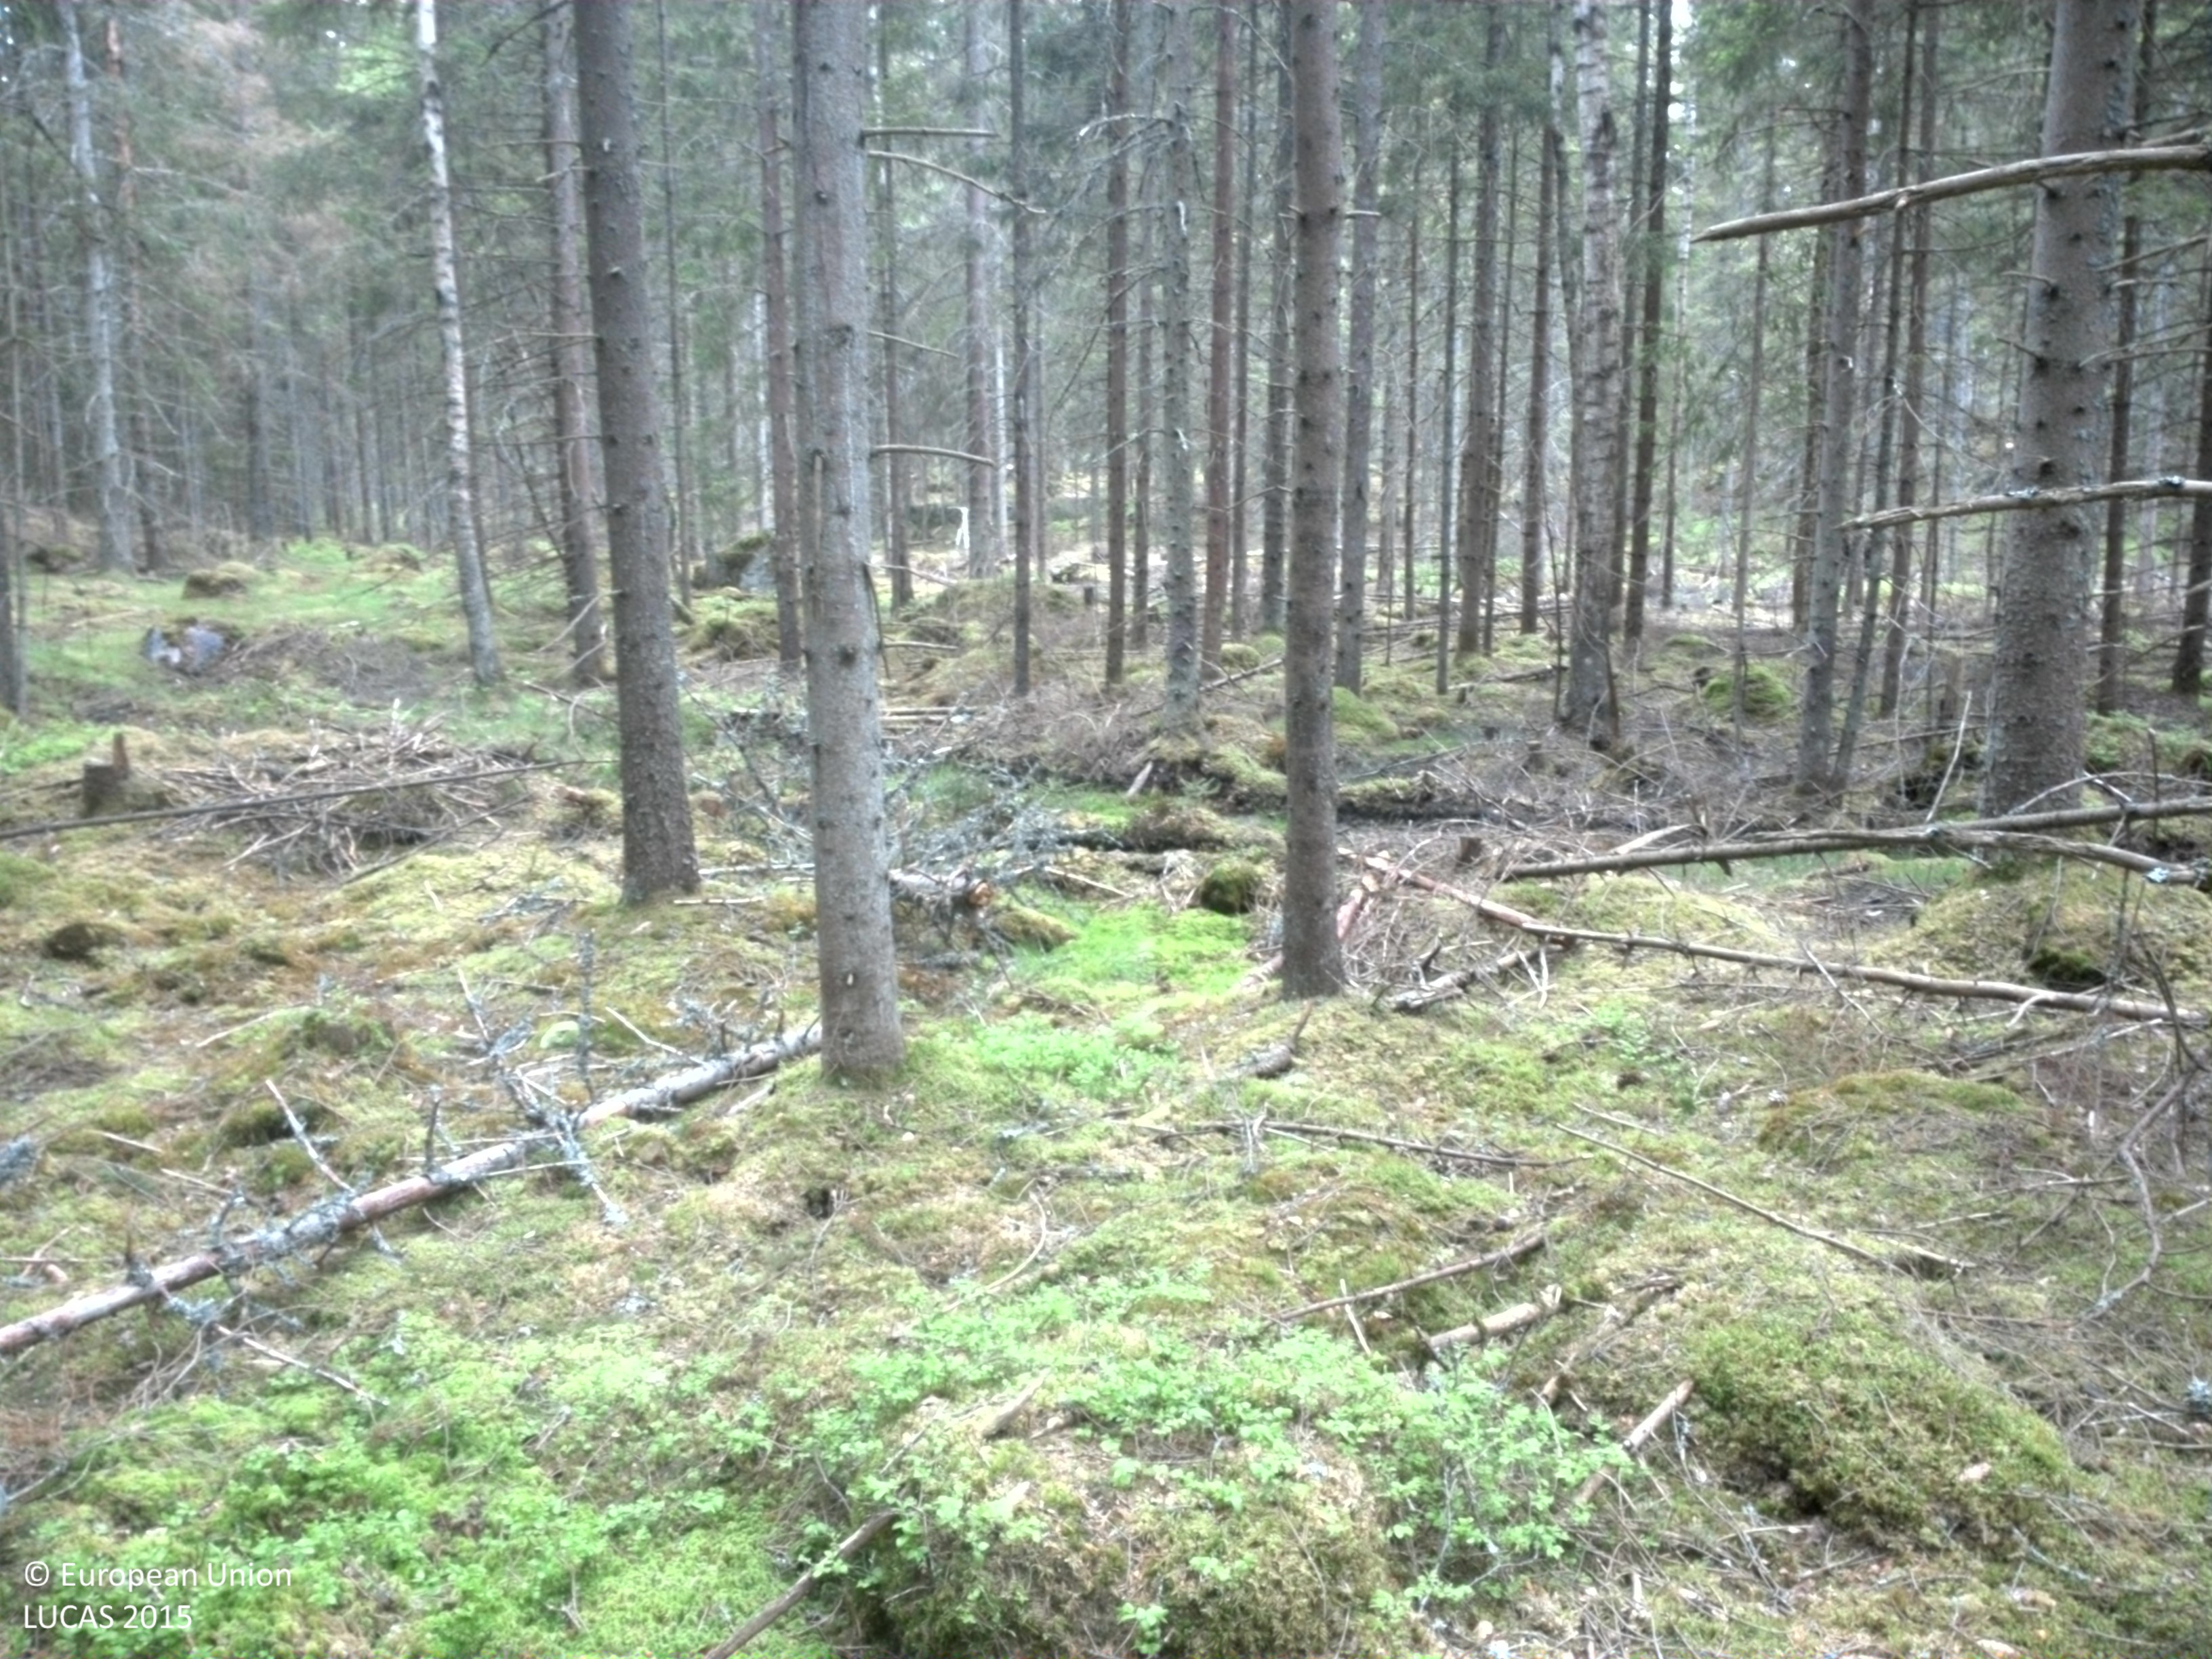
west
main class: Woodland
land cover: Spruce dominated coniferous woodland
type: boreal forest
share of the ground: > 75 %
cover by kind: coniferous forest trees 85 %, lichens and mosses 10 %, broadleaved forest trees 5 %
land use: Forestry
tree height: > 5 m
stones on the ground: < 10 %
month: May
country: SE
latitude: 56.5540
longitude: 15.1228
